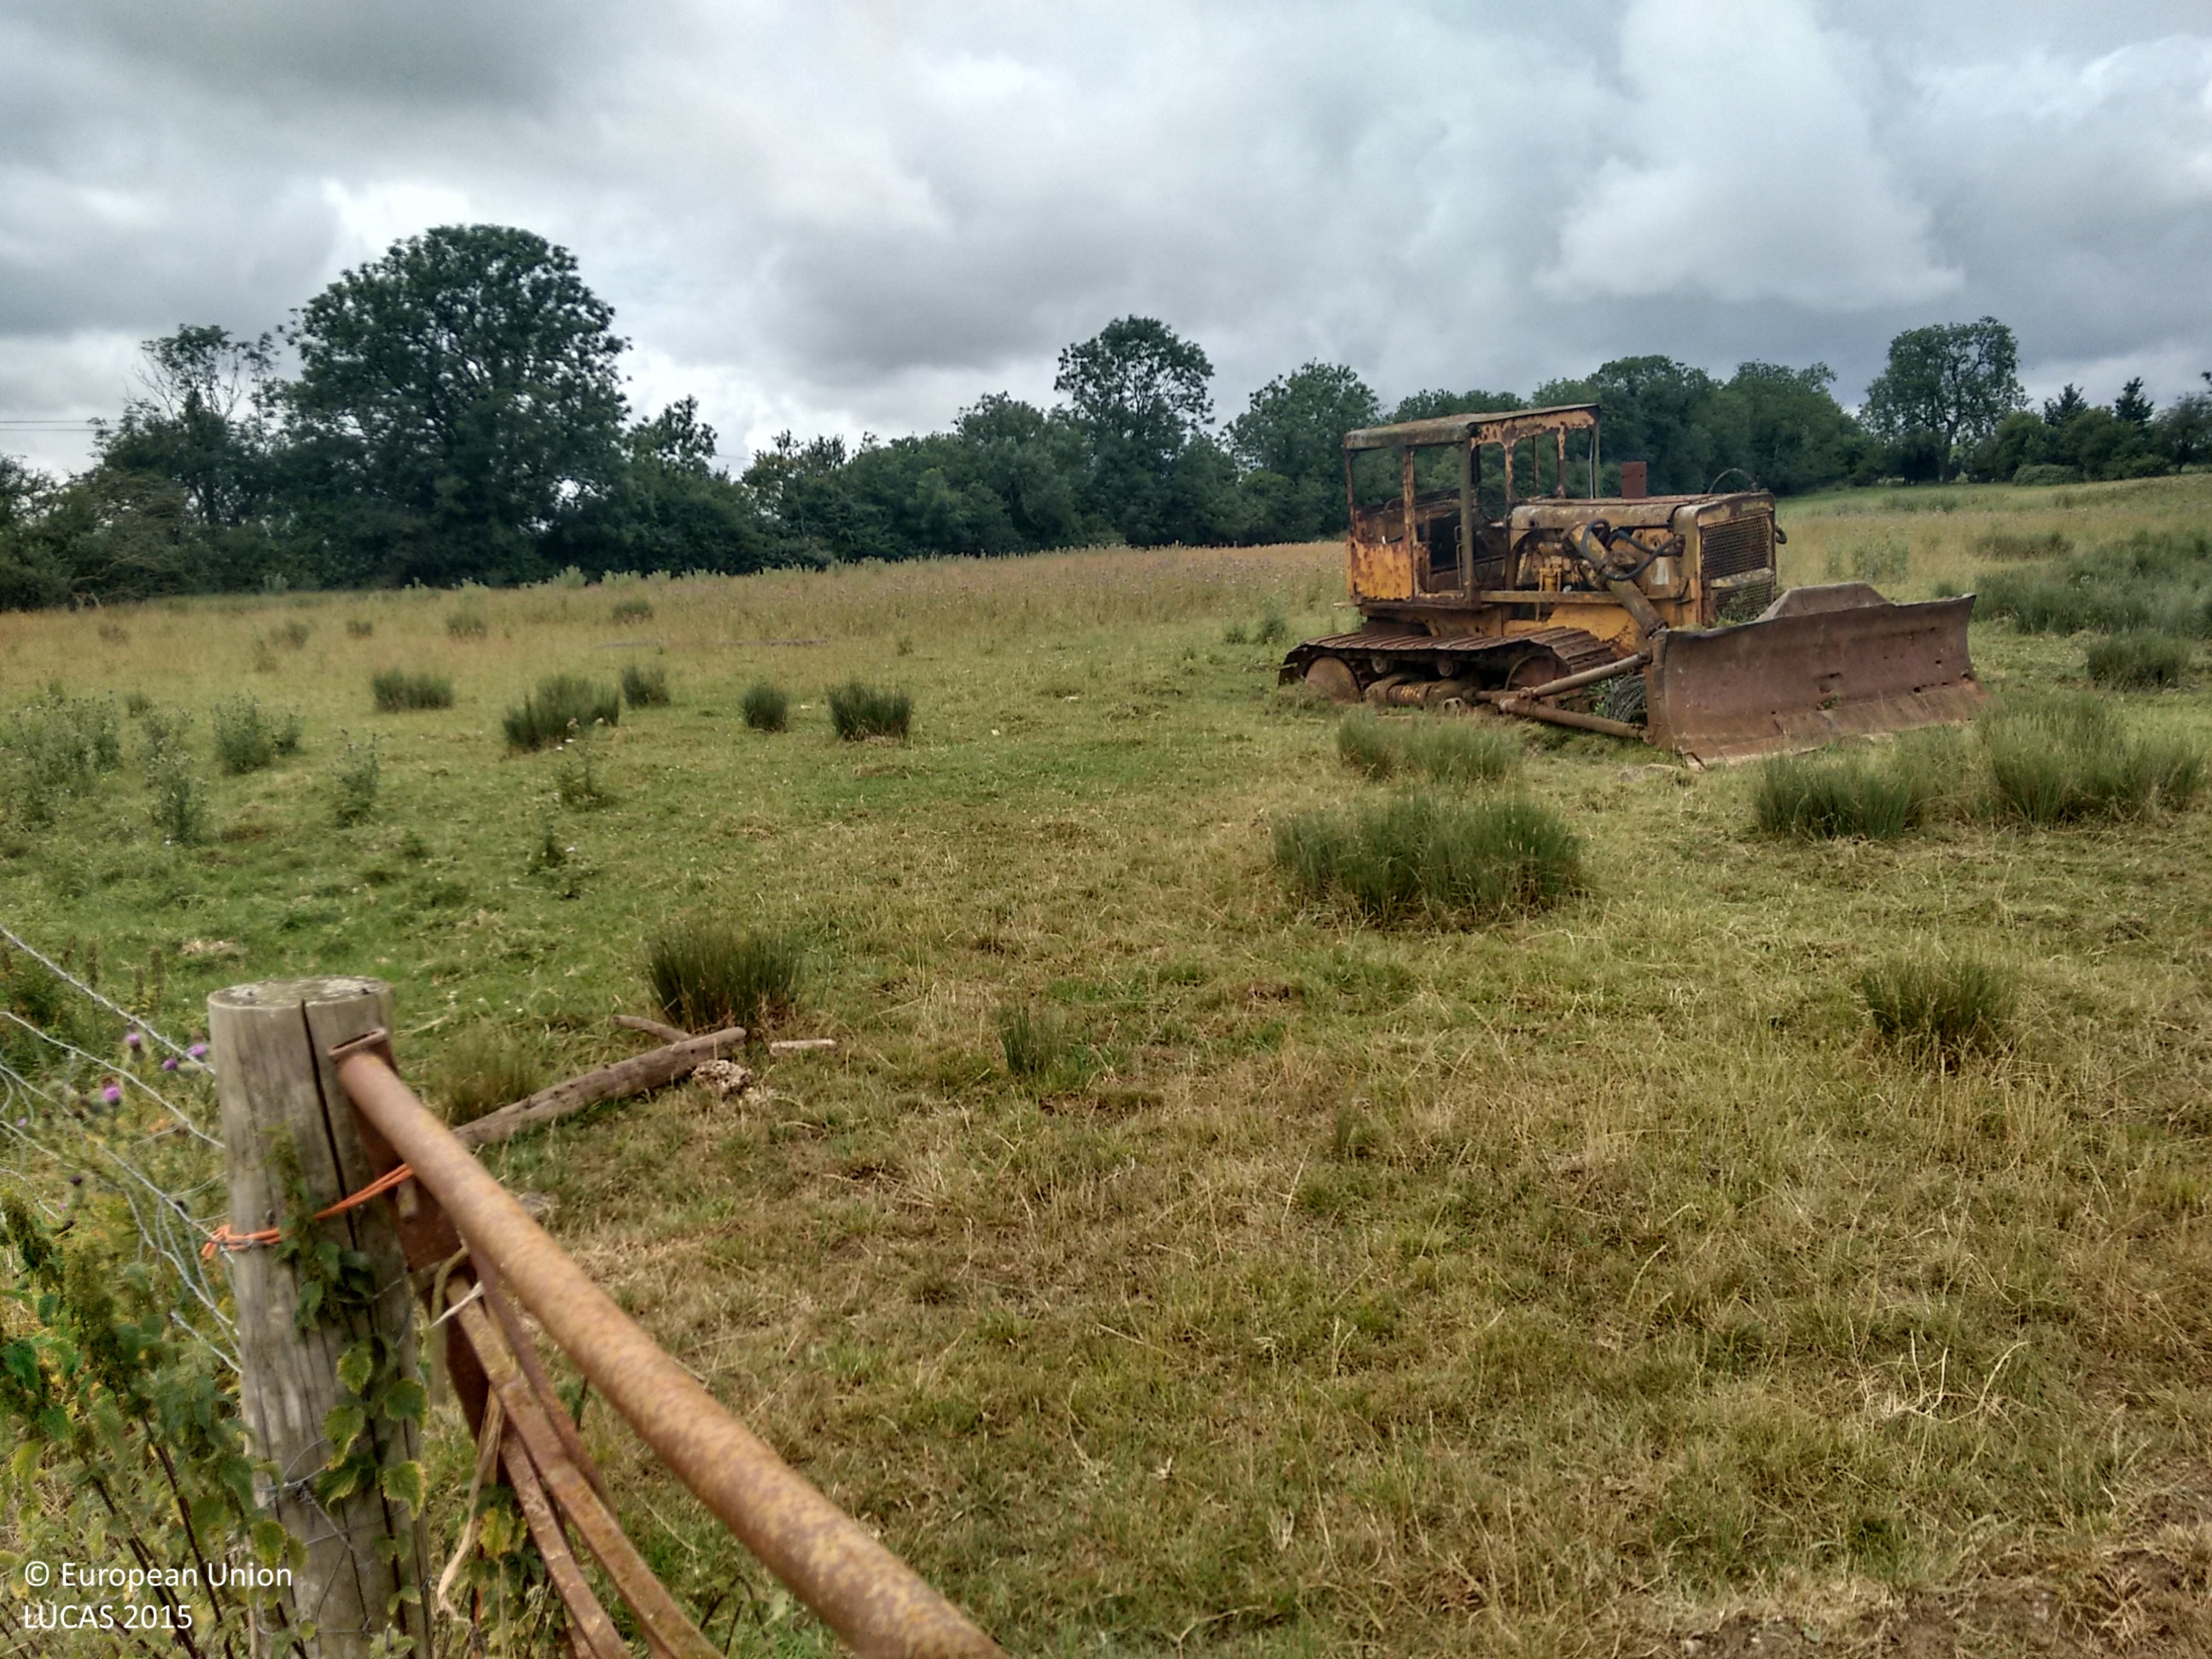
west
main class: Grassland
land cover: Grassland without tree/shrub cover
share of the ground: > 75 %
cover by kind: herbaceous plants 100 %
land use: Agriculture (excluding fallow land and kitchen gardens)
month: July
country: GB
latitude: 51.5076
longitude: -2.3833
